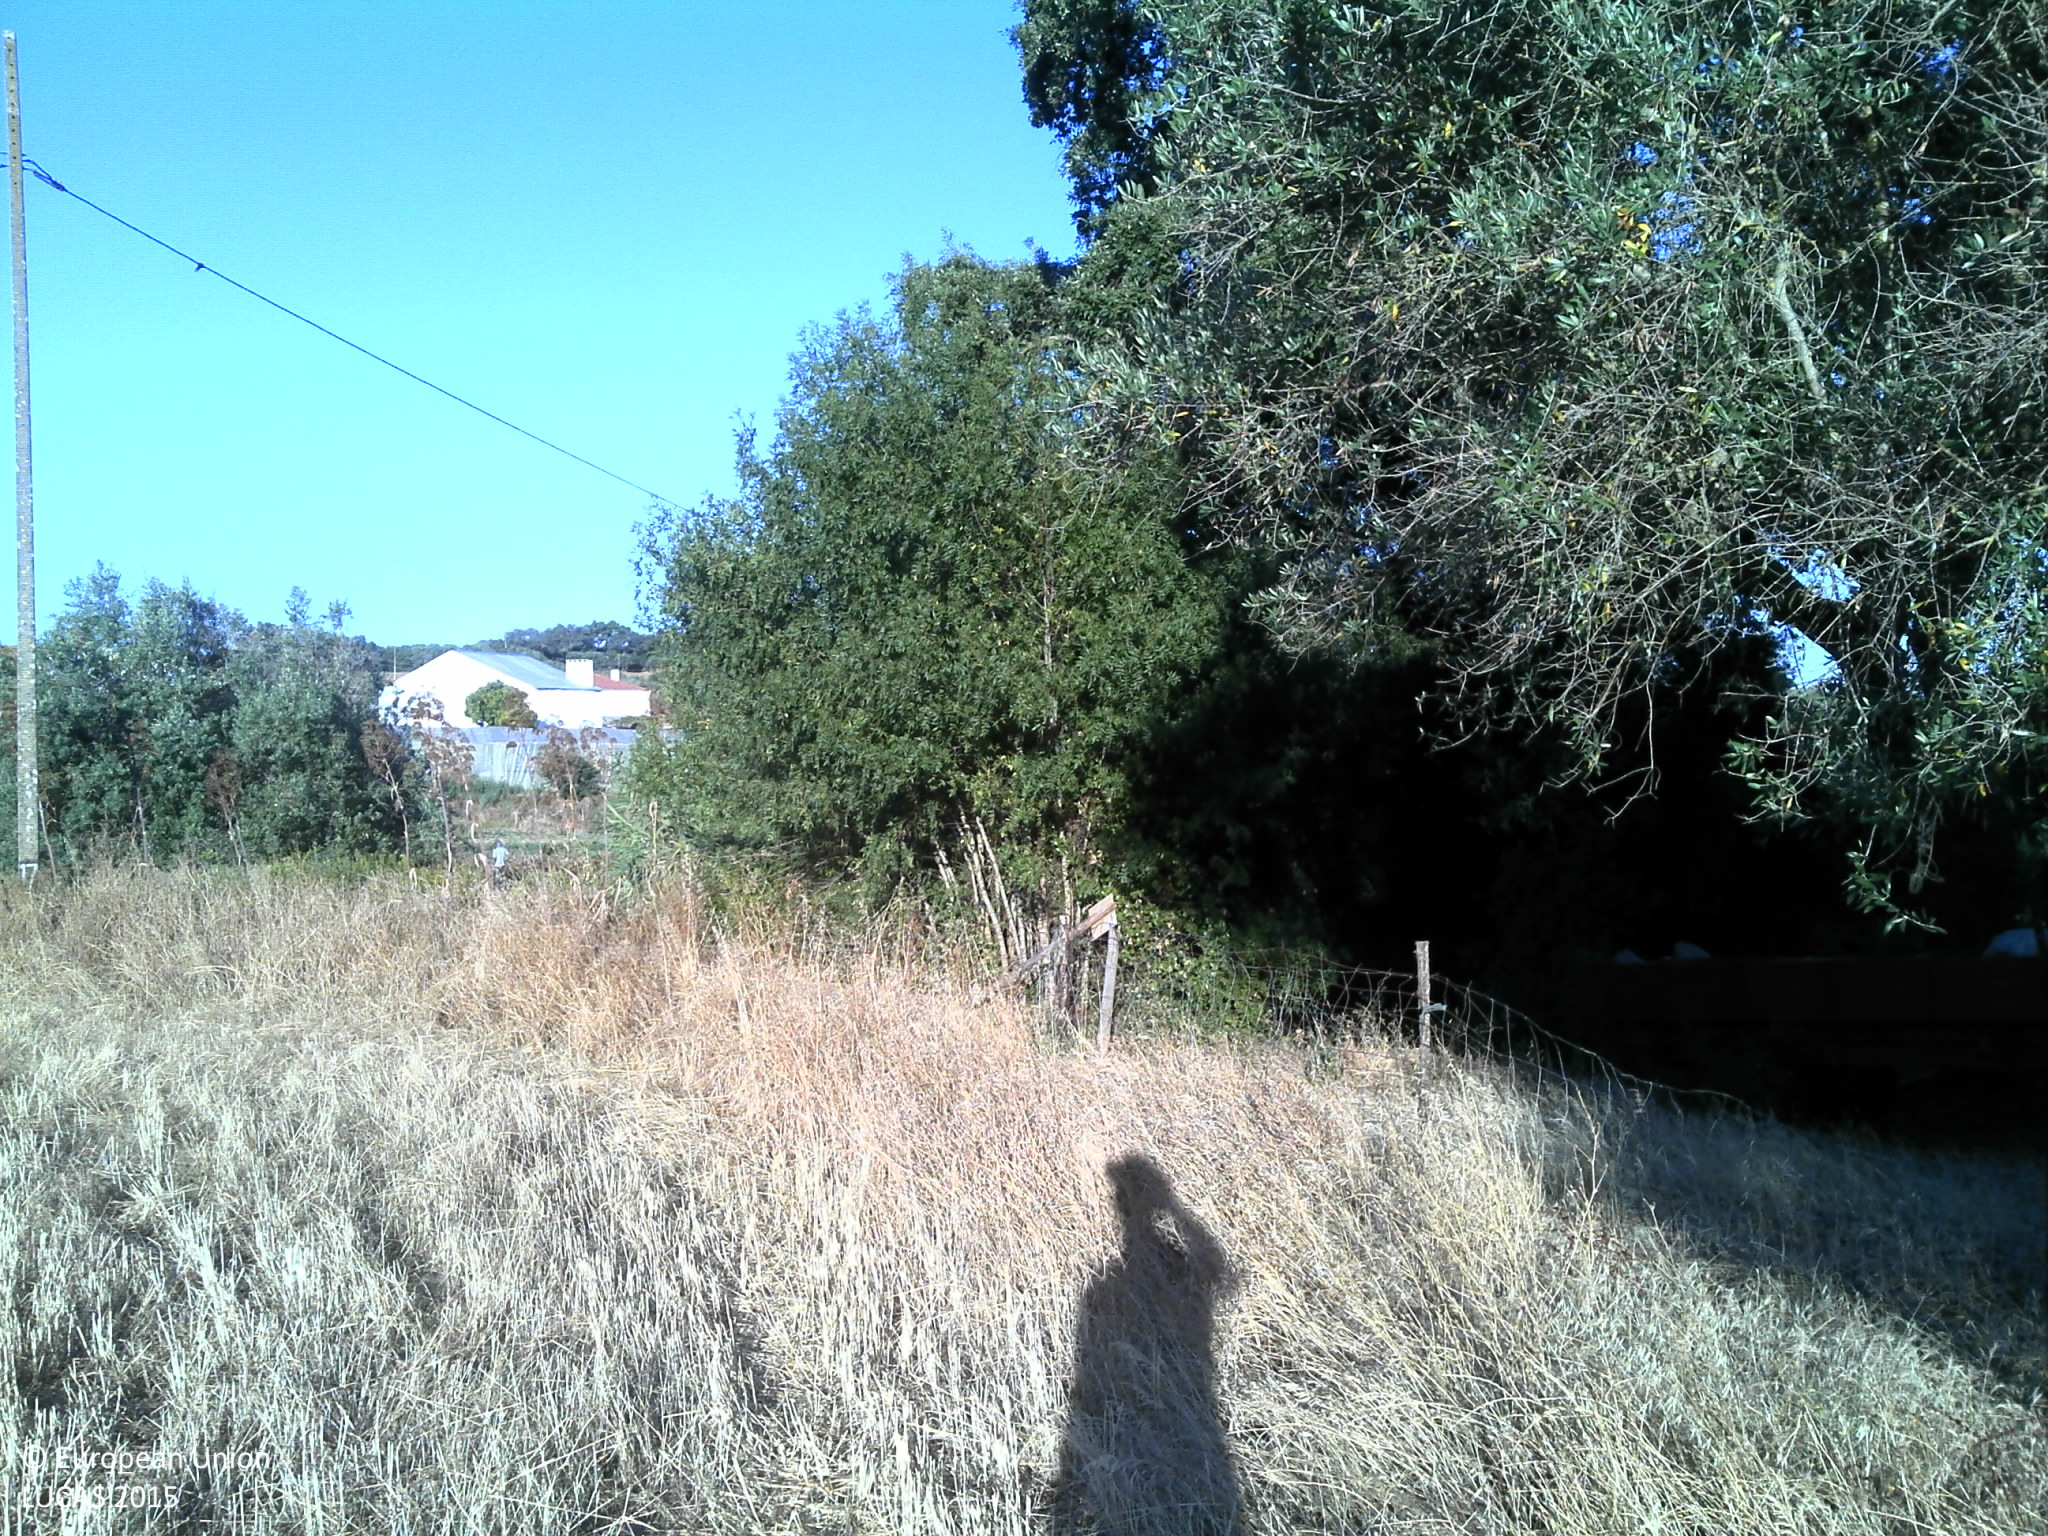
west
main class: Cropland
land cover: Triticale
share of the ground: < 10 %
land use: Agriculture (excluding fallow land and kitchen gardens)
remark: Harvested field
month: July
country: PT
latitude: 38.8712
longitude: -7.5678
